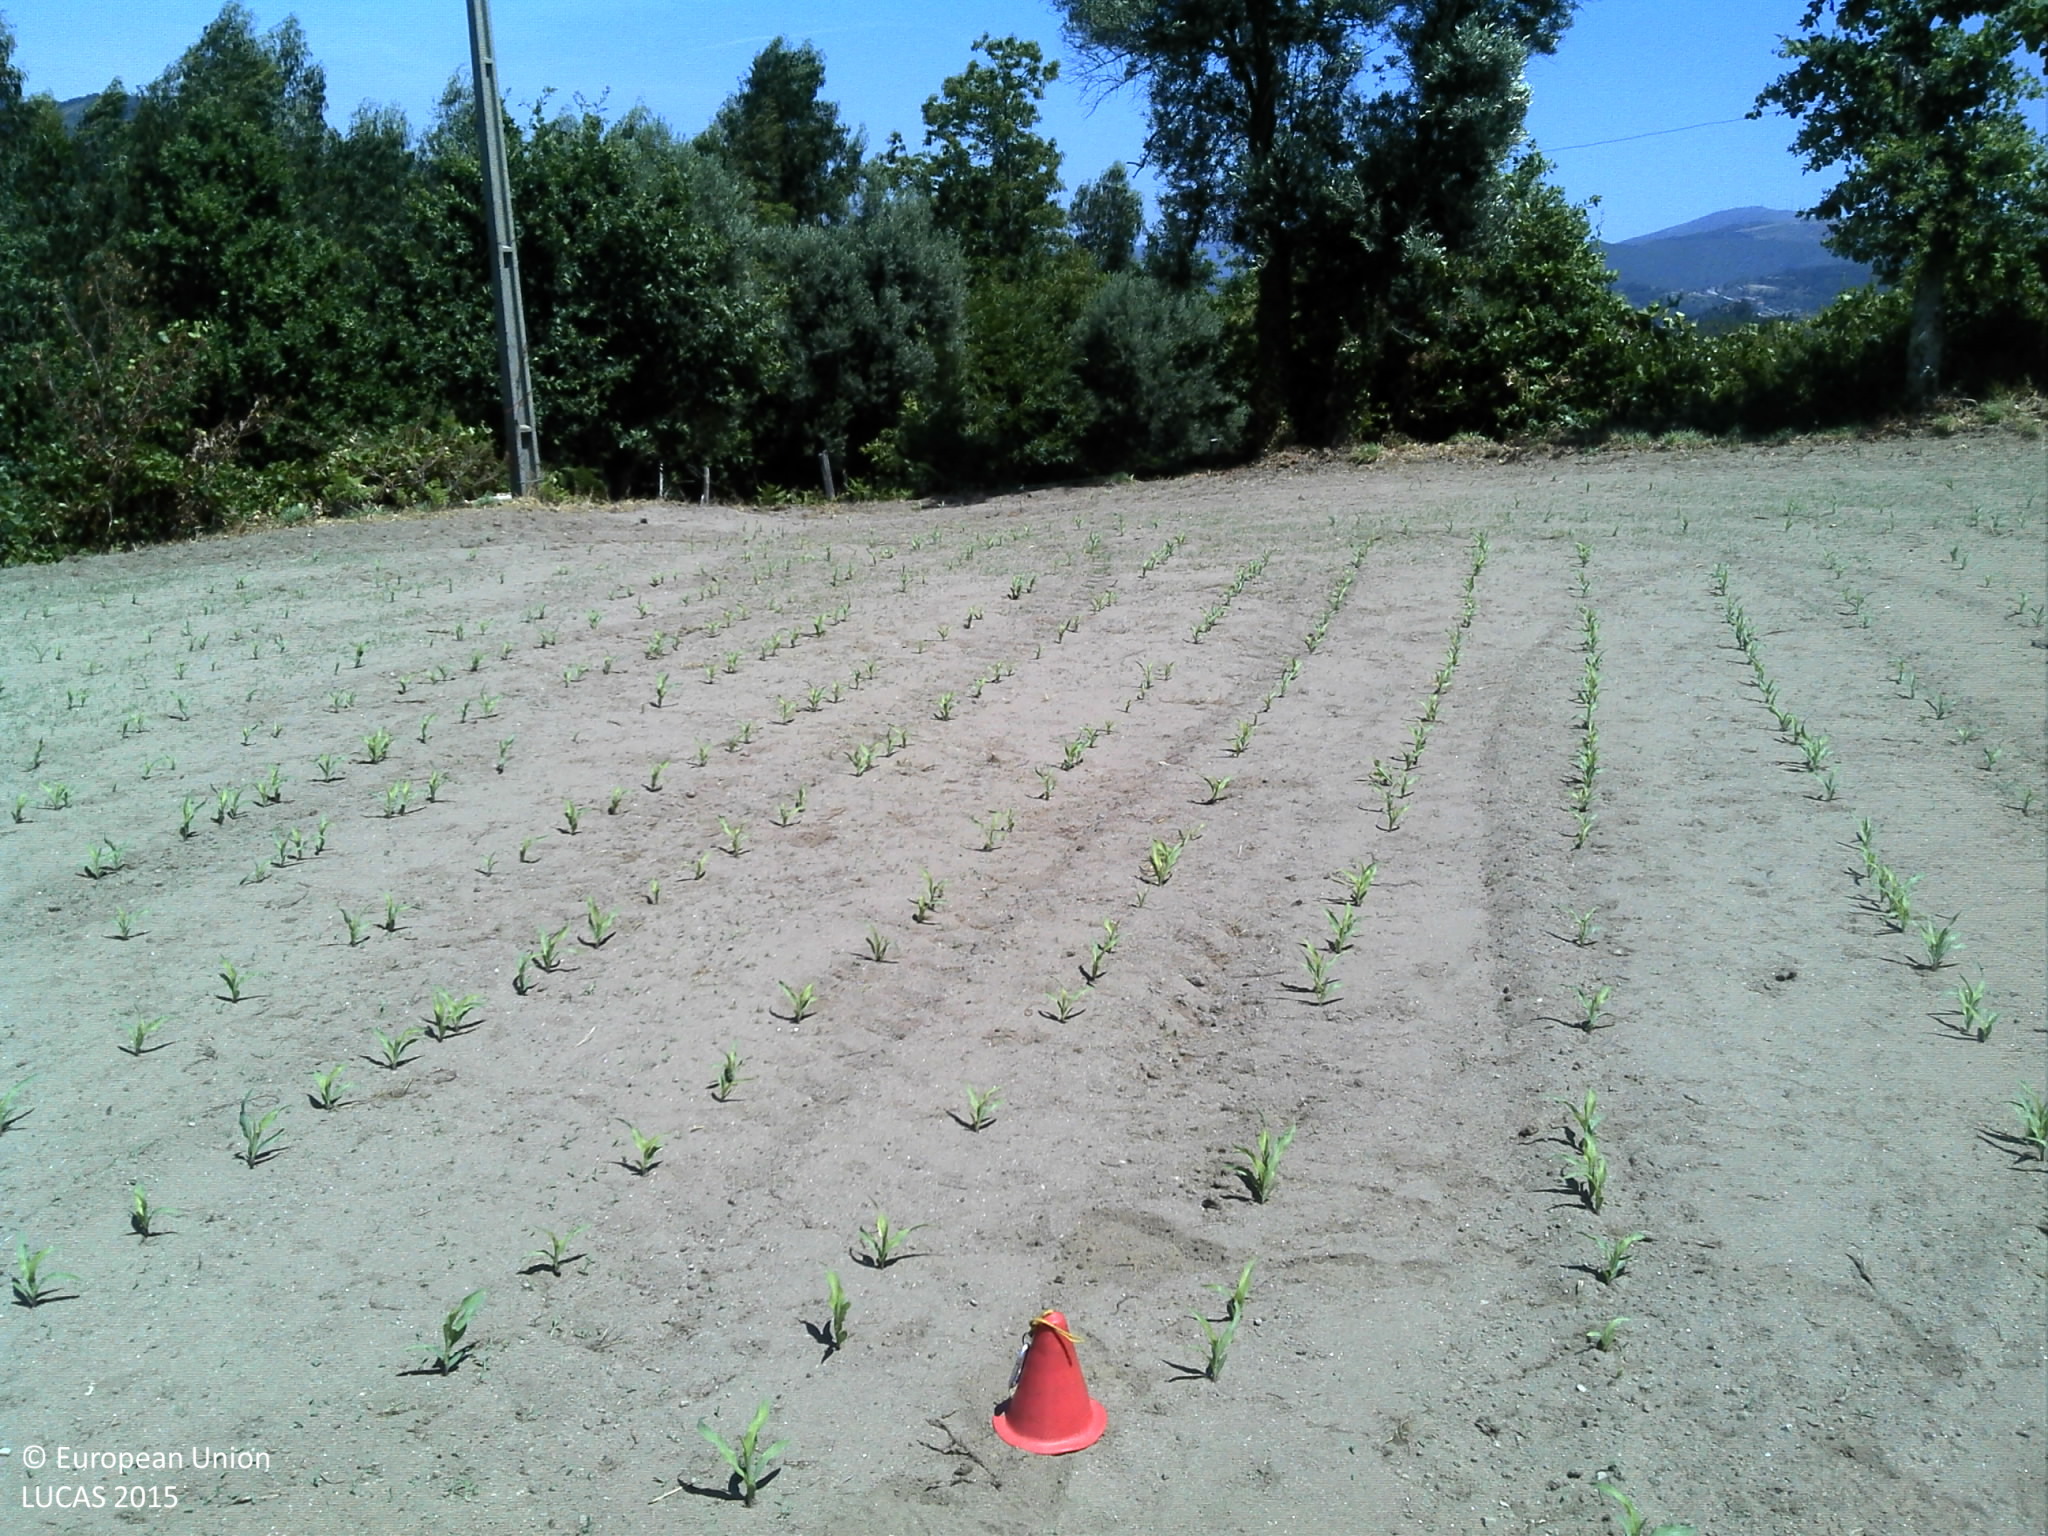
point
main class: Cropland
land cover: Maize
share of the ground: < 10 %
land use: Agriculture (excluding fallow land and kitchen gardens)
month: July
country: PT
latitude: 41.5172
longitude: -7.8349
